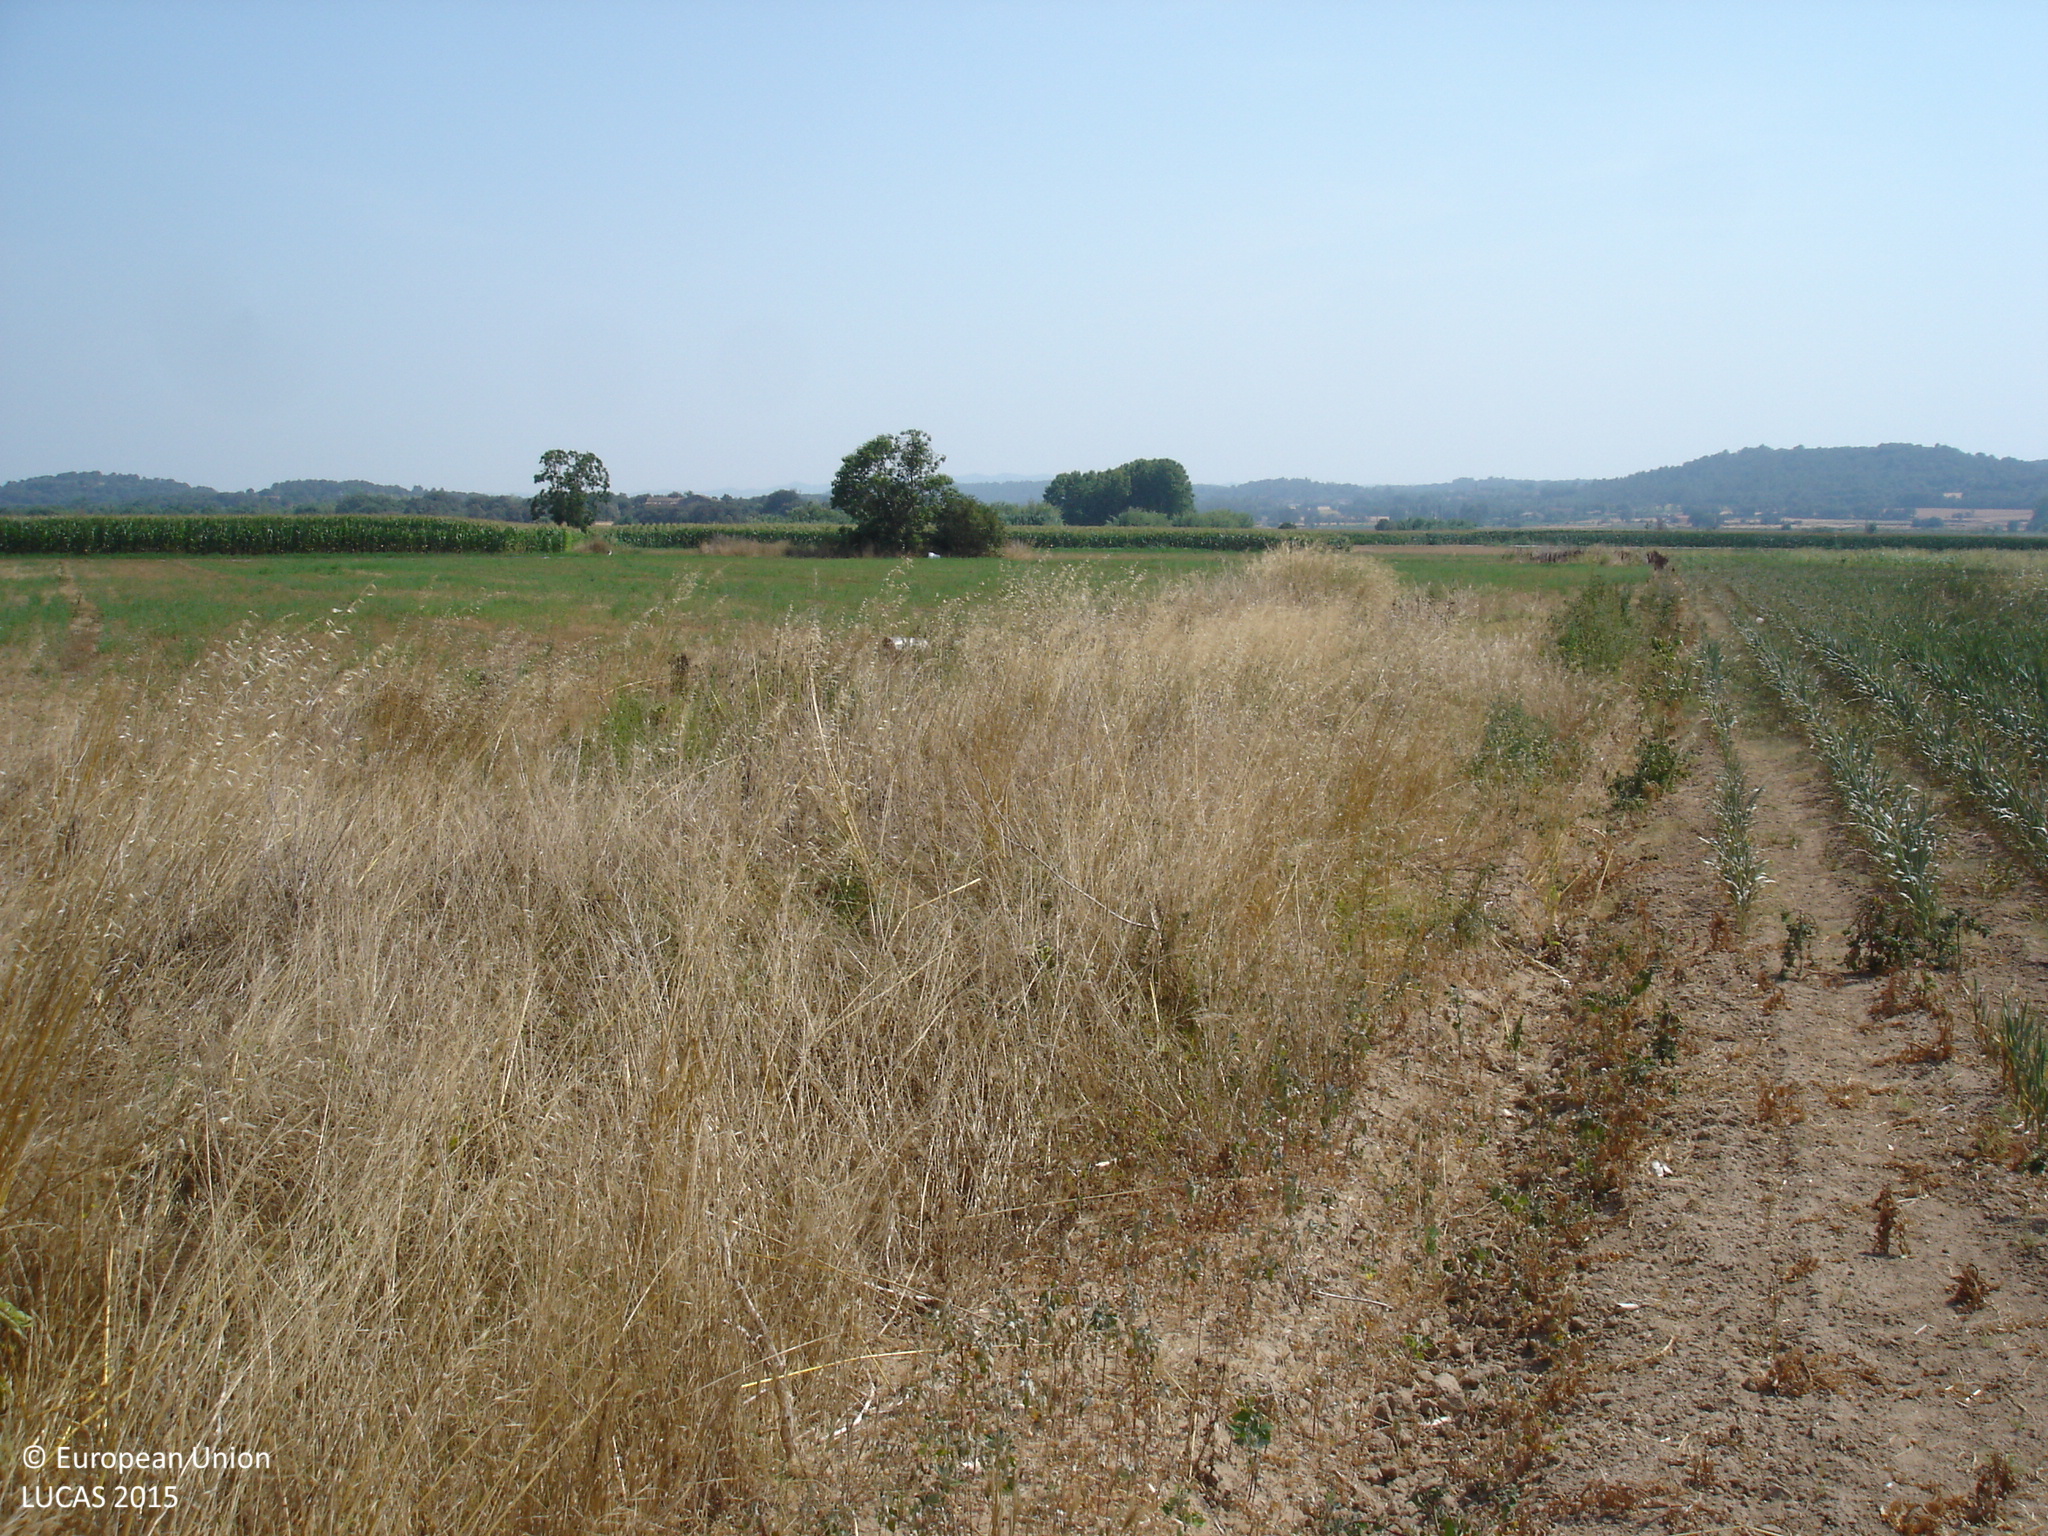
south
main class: Cropland
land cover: Maize
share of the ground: 10 - 25 %
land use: Agriculture (excluding fallow land and kitchen gardens)
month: July
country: ES
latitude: 42.0506
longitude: 3.0197
